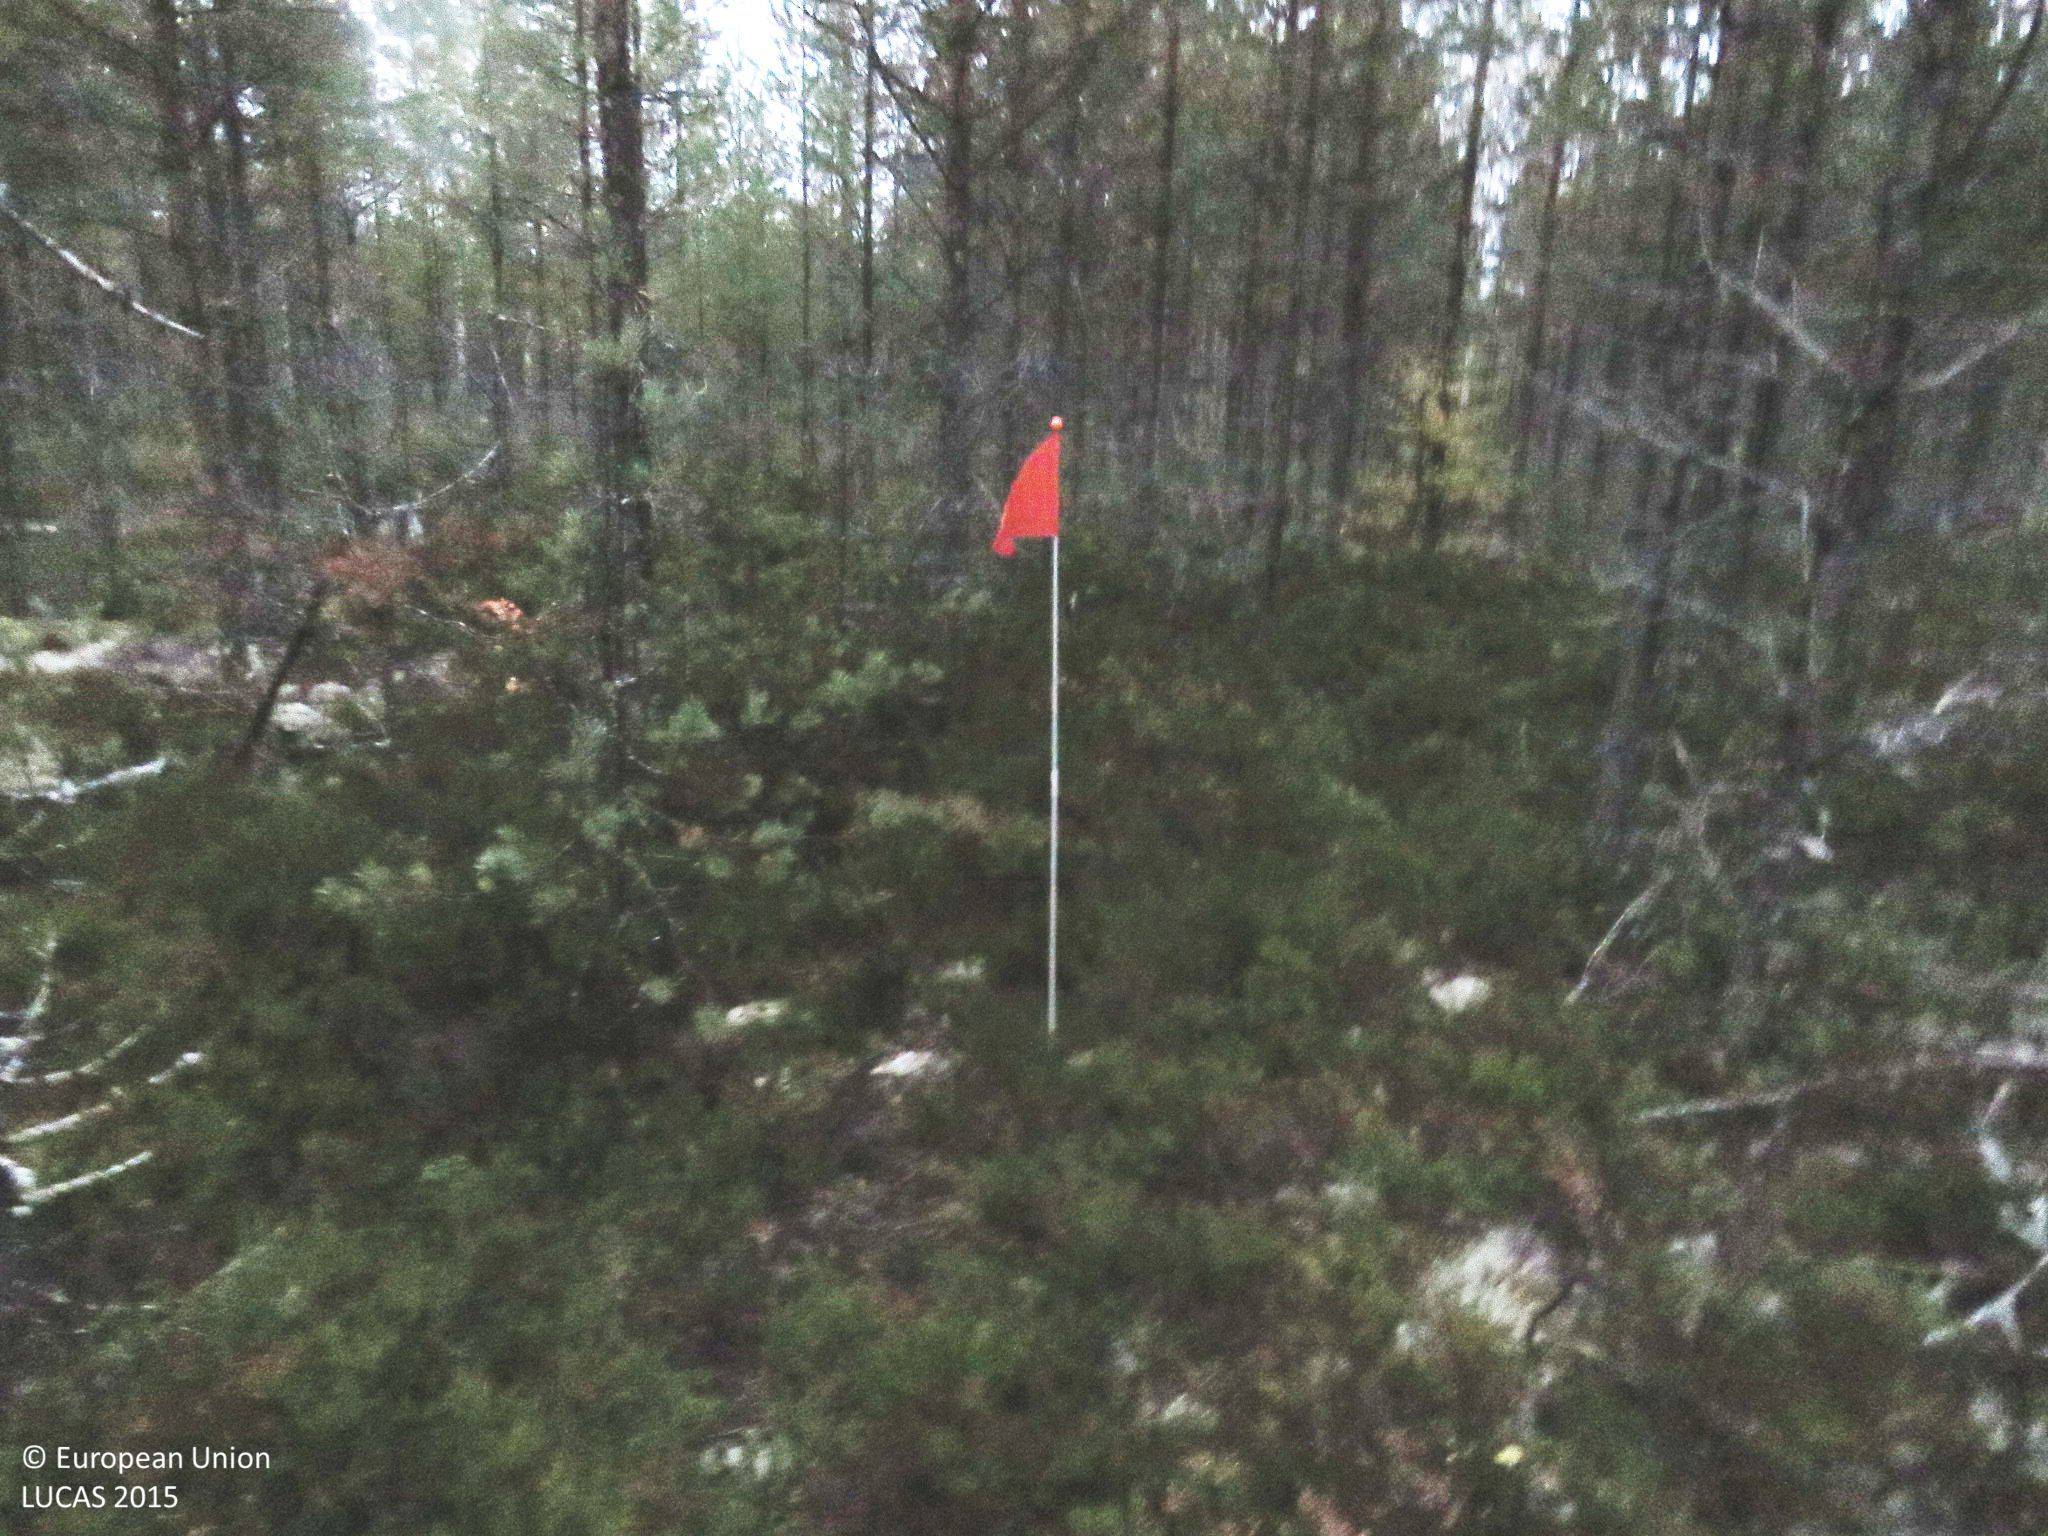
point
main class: Woodland
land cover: Pine dominated coniferous woodland
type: boreal forest
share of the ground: > 75 %
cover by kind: coniferous forest trees 65 %, shrubs 20 %, broadleaved forest trees 10 %, lichens and mosses 5 %
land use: Forestry
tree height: > 5 m
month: September
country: FI
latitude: 64.7955
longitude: 26.5922
